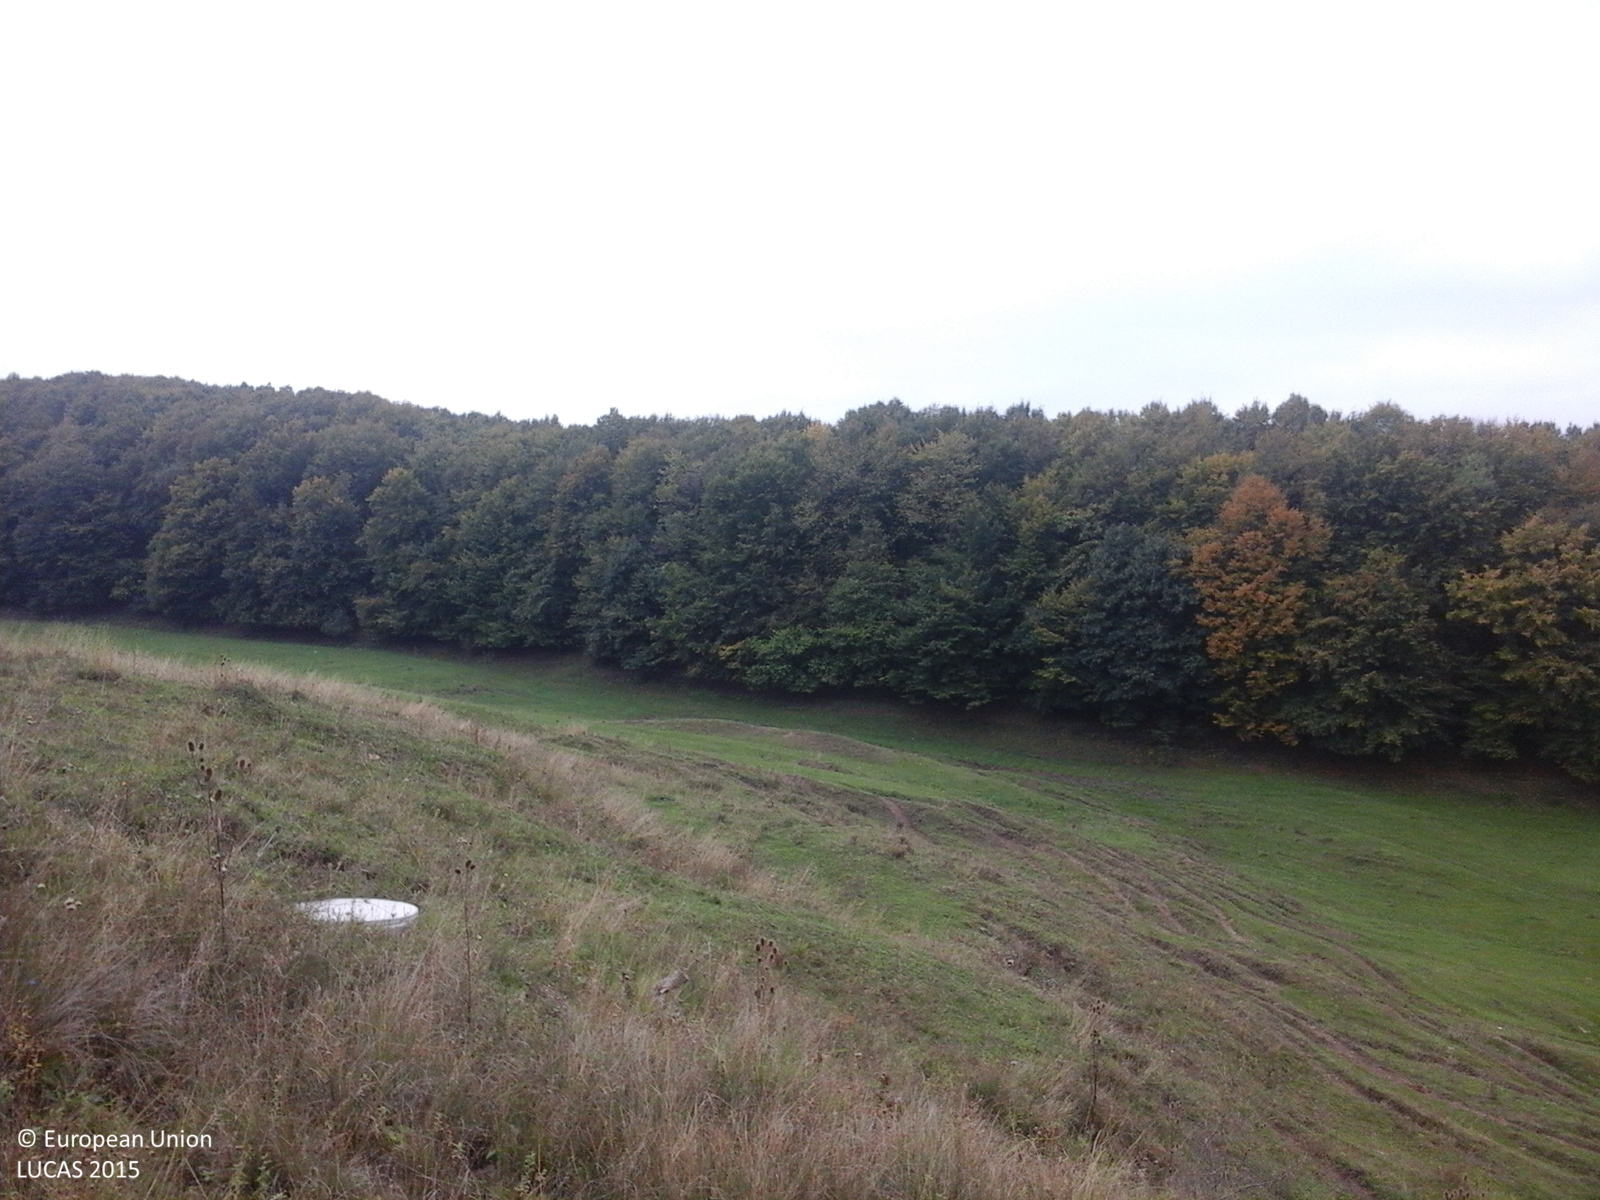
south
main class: Grassland
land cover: Grassland without tree/shrub cover
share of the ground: > 75 %
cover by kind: herbaceous plants 100 %
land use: Agriculture (excluding fallow land and kitchen gardens)
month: October
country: RO
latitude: 46.0453
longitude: 24.8092
